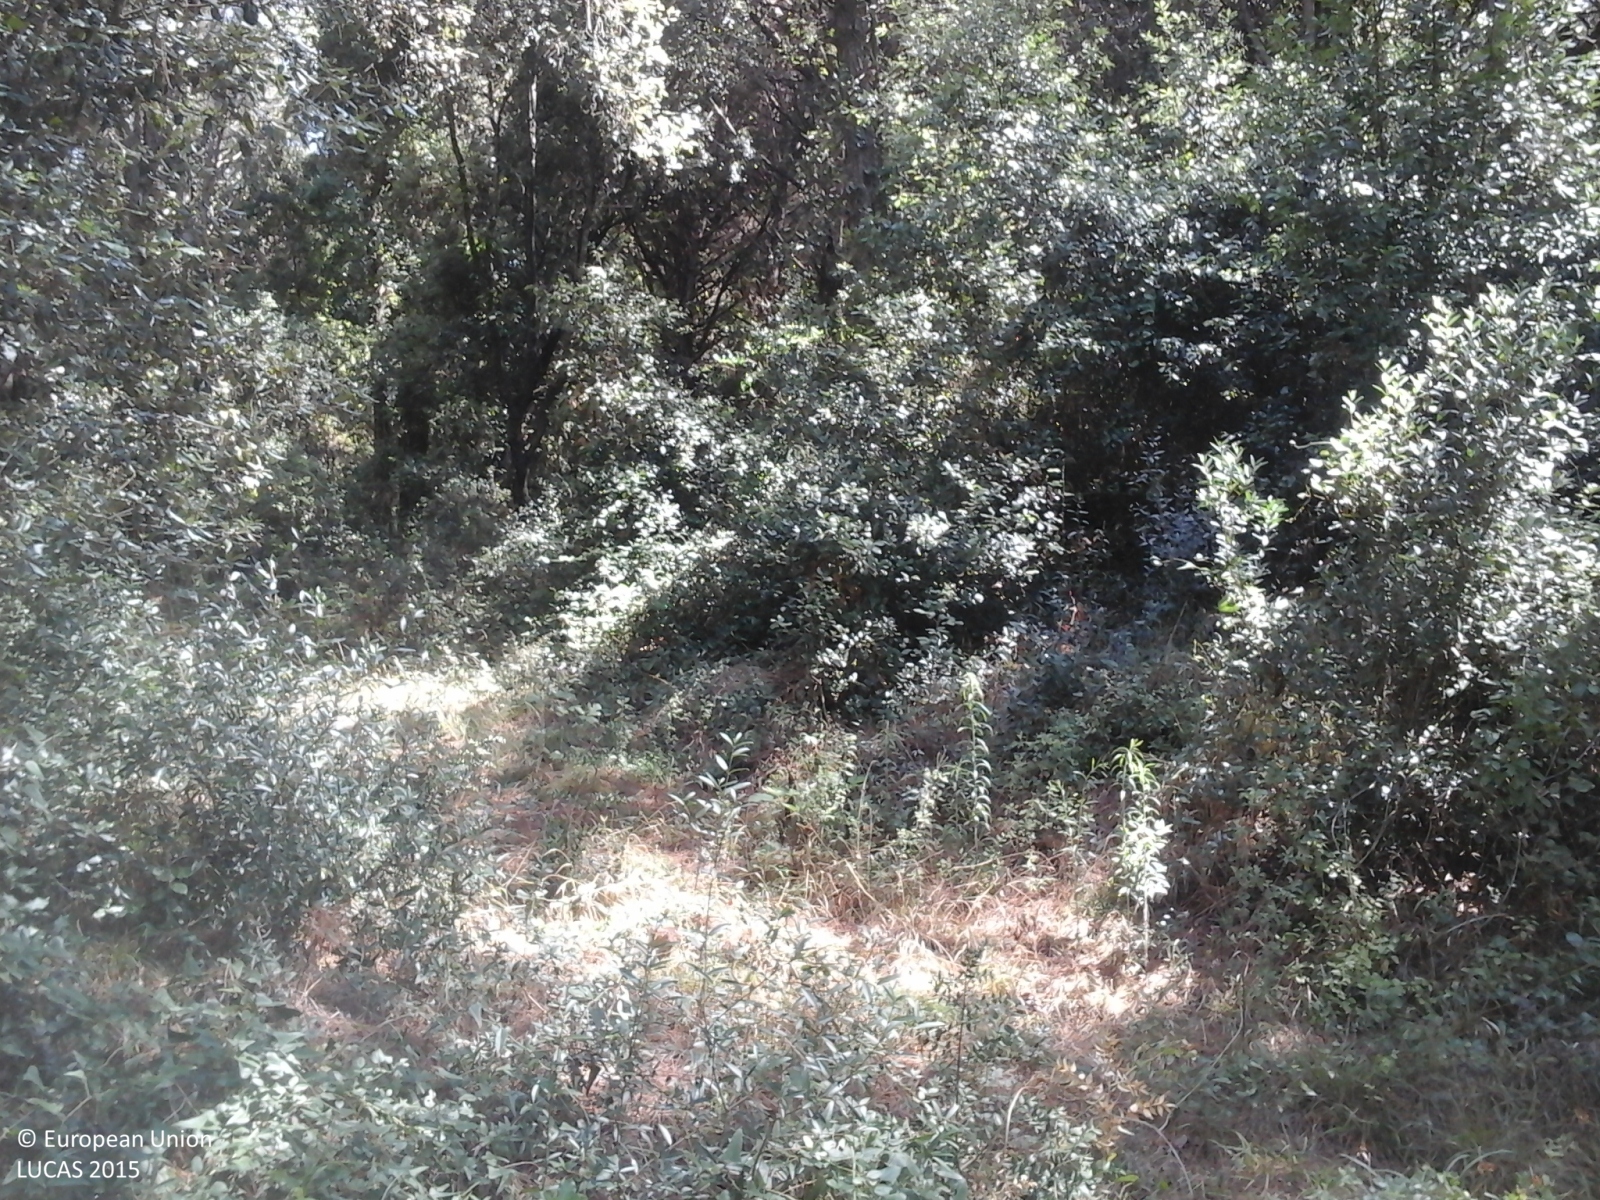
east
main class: Woodland
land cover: Pine dominated coniferous woodland
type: coniferous forest of the mediterranean region
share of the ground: > 75 %
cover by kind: coniferous forest trees 100 %
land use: Forestry
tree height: > 5 m
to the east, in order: Pine dominated coniferous woodland; Tracks; Pine dominated coniferous woodland; Tracks
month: August
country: IT
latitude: 43.6646
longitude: 10.2844
